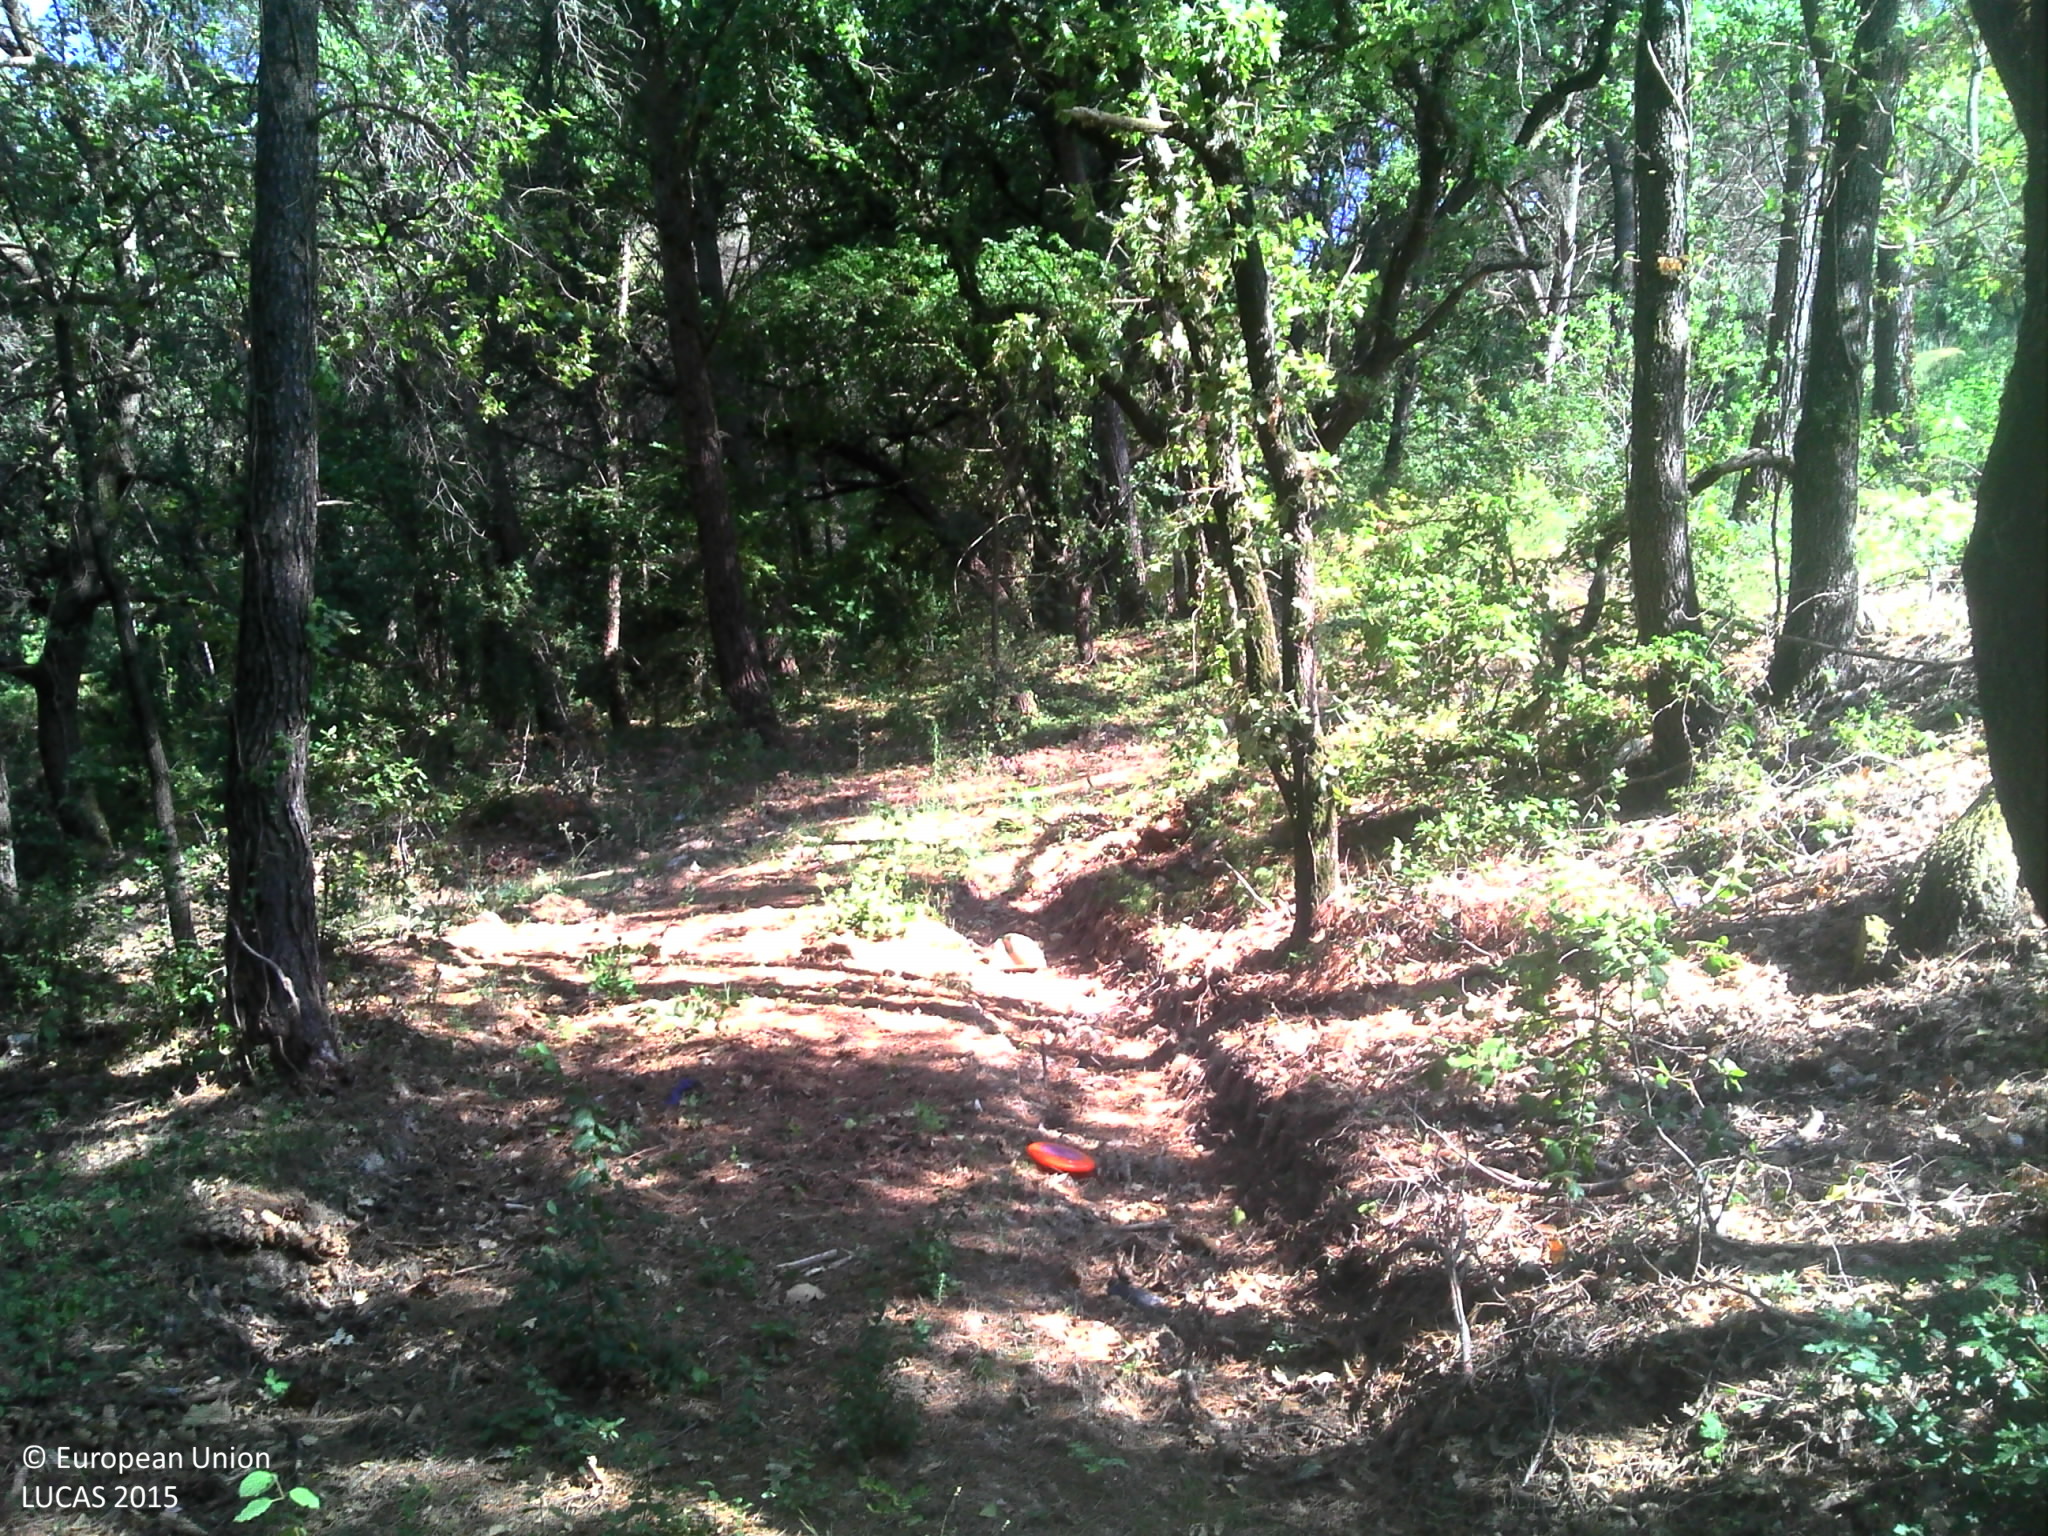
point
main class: Woodland
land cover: Pine dominated mixed woodland
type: coniferous forest of the mediterranean region
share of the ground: > 75 %
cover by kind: coniferous forest trees 50 %, broadleaved forest trees 50 %
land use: Forestry
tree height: > 5 m
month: August
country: FR
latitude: 43.3880
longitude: 5.5535
